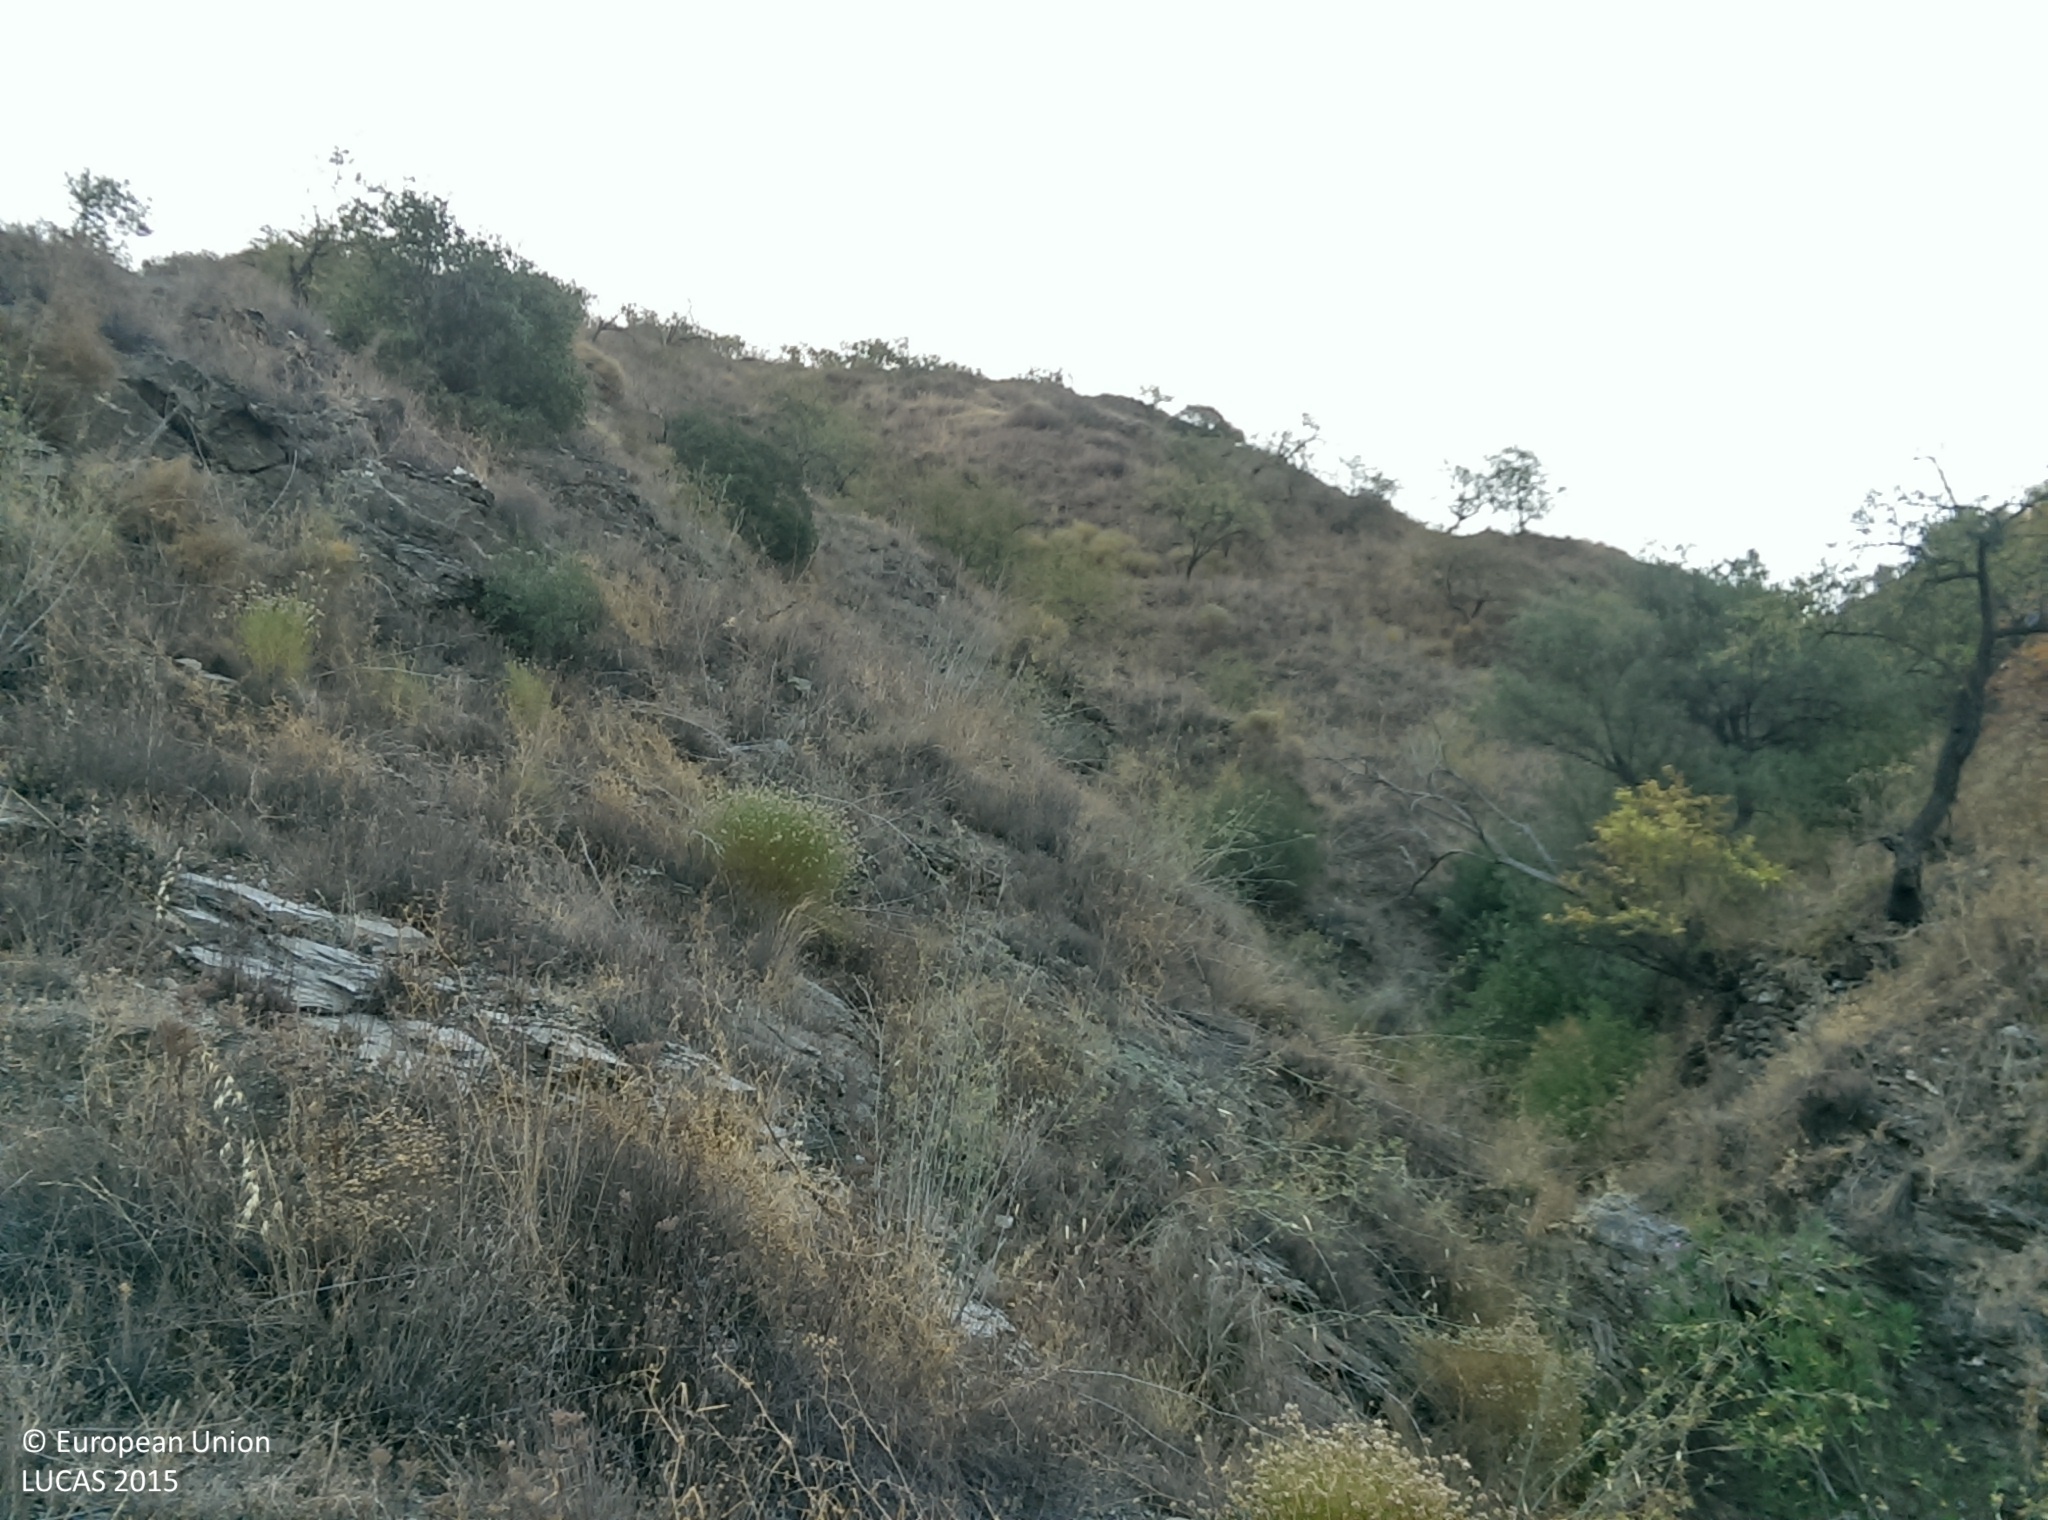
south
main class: Cropland
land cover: Nuts trees
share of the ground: 10 - 25 %
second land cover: Spontaneously vegetated surfaces
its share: 50 - 75 %
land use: Abandoned areas
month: August
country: ES
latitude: 36.7968
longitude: -3.1252
